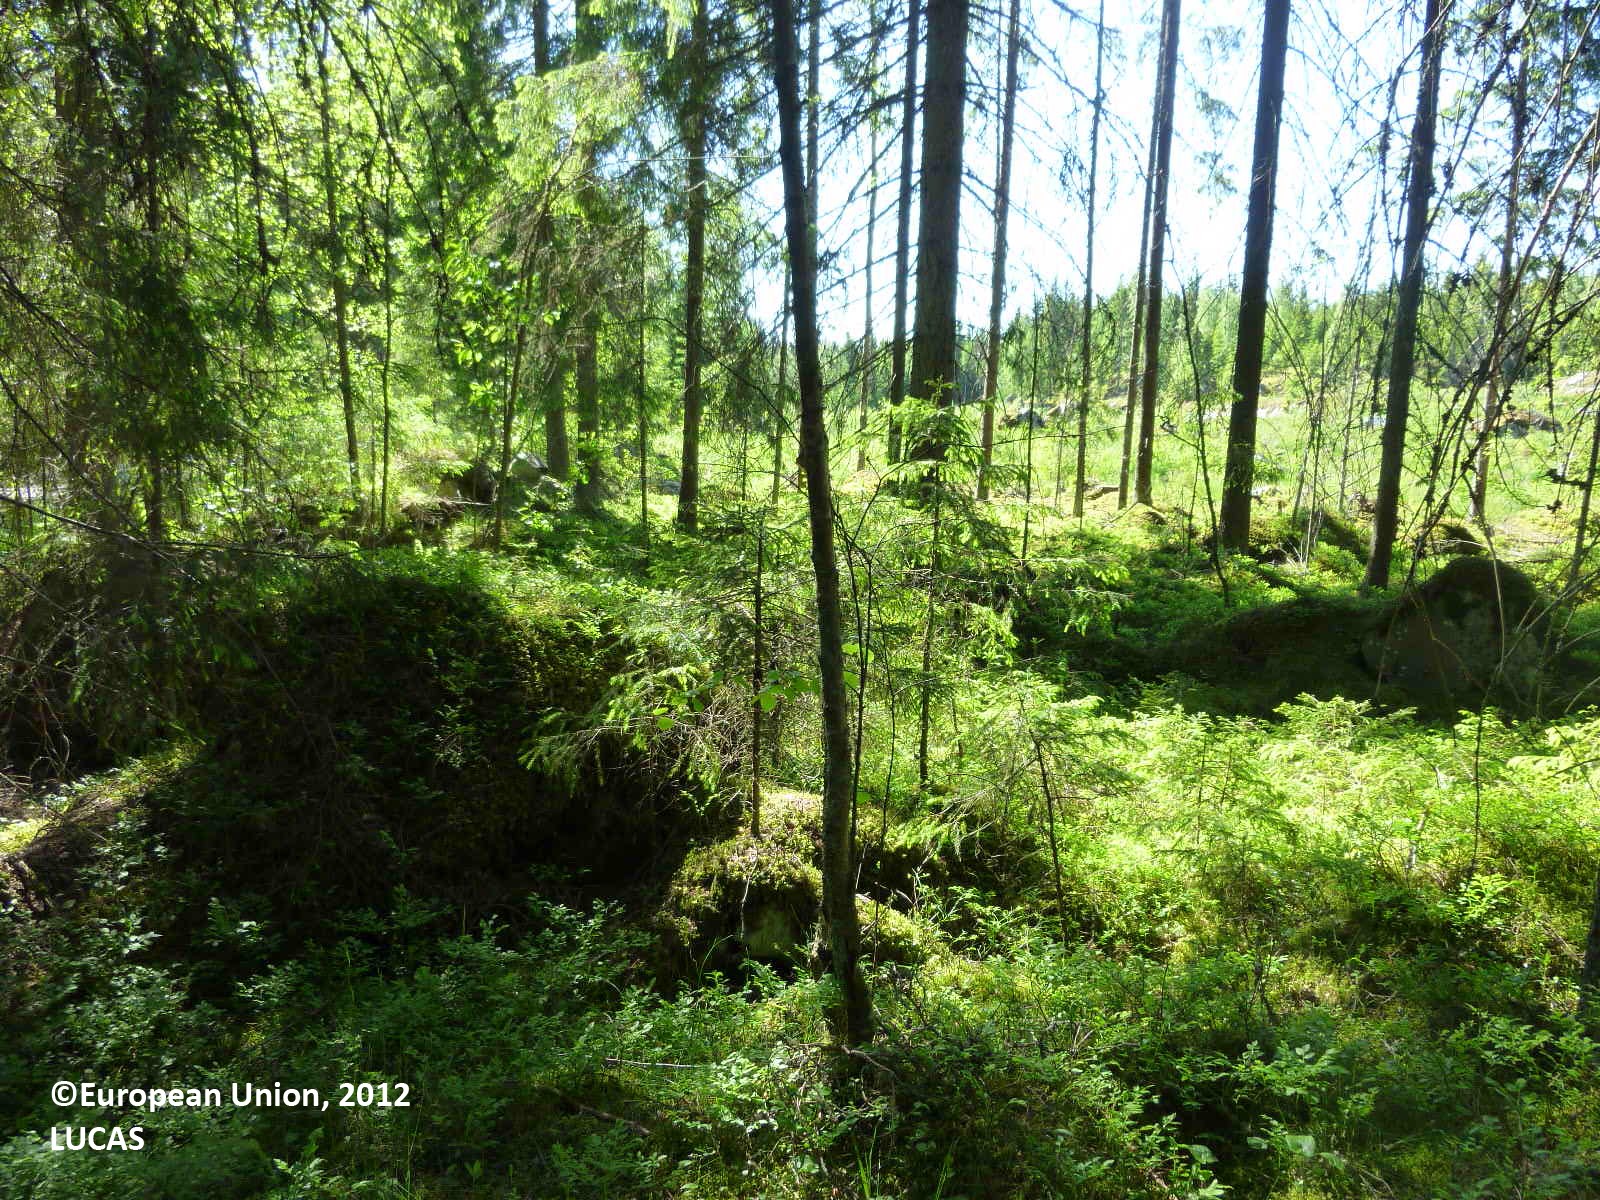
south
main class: Woodland
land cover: Spruce dominated coniferous woodland
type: boreal forest
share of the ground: > 75 %
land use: Forestry
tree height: > 5 m
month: June
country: FI
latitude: 61.4940
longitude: 22.8220
